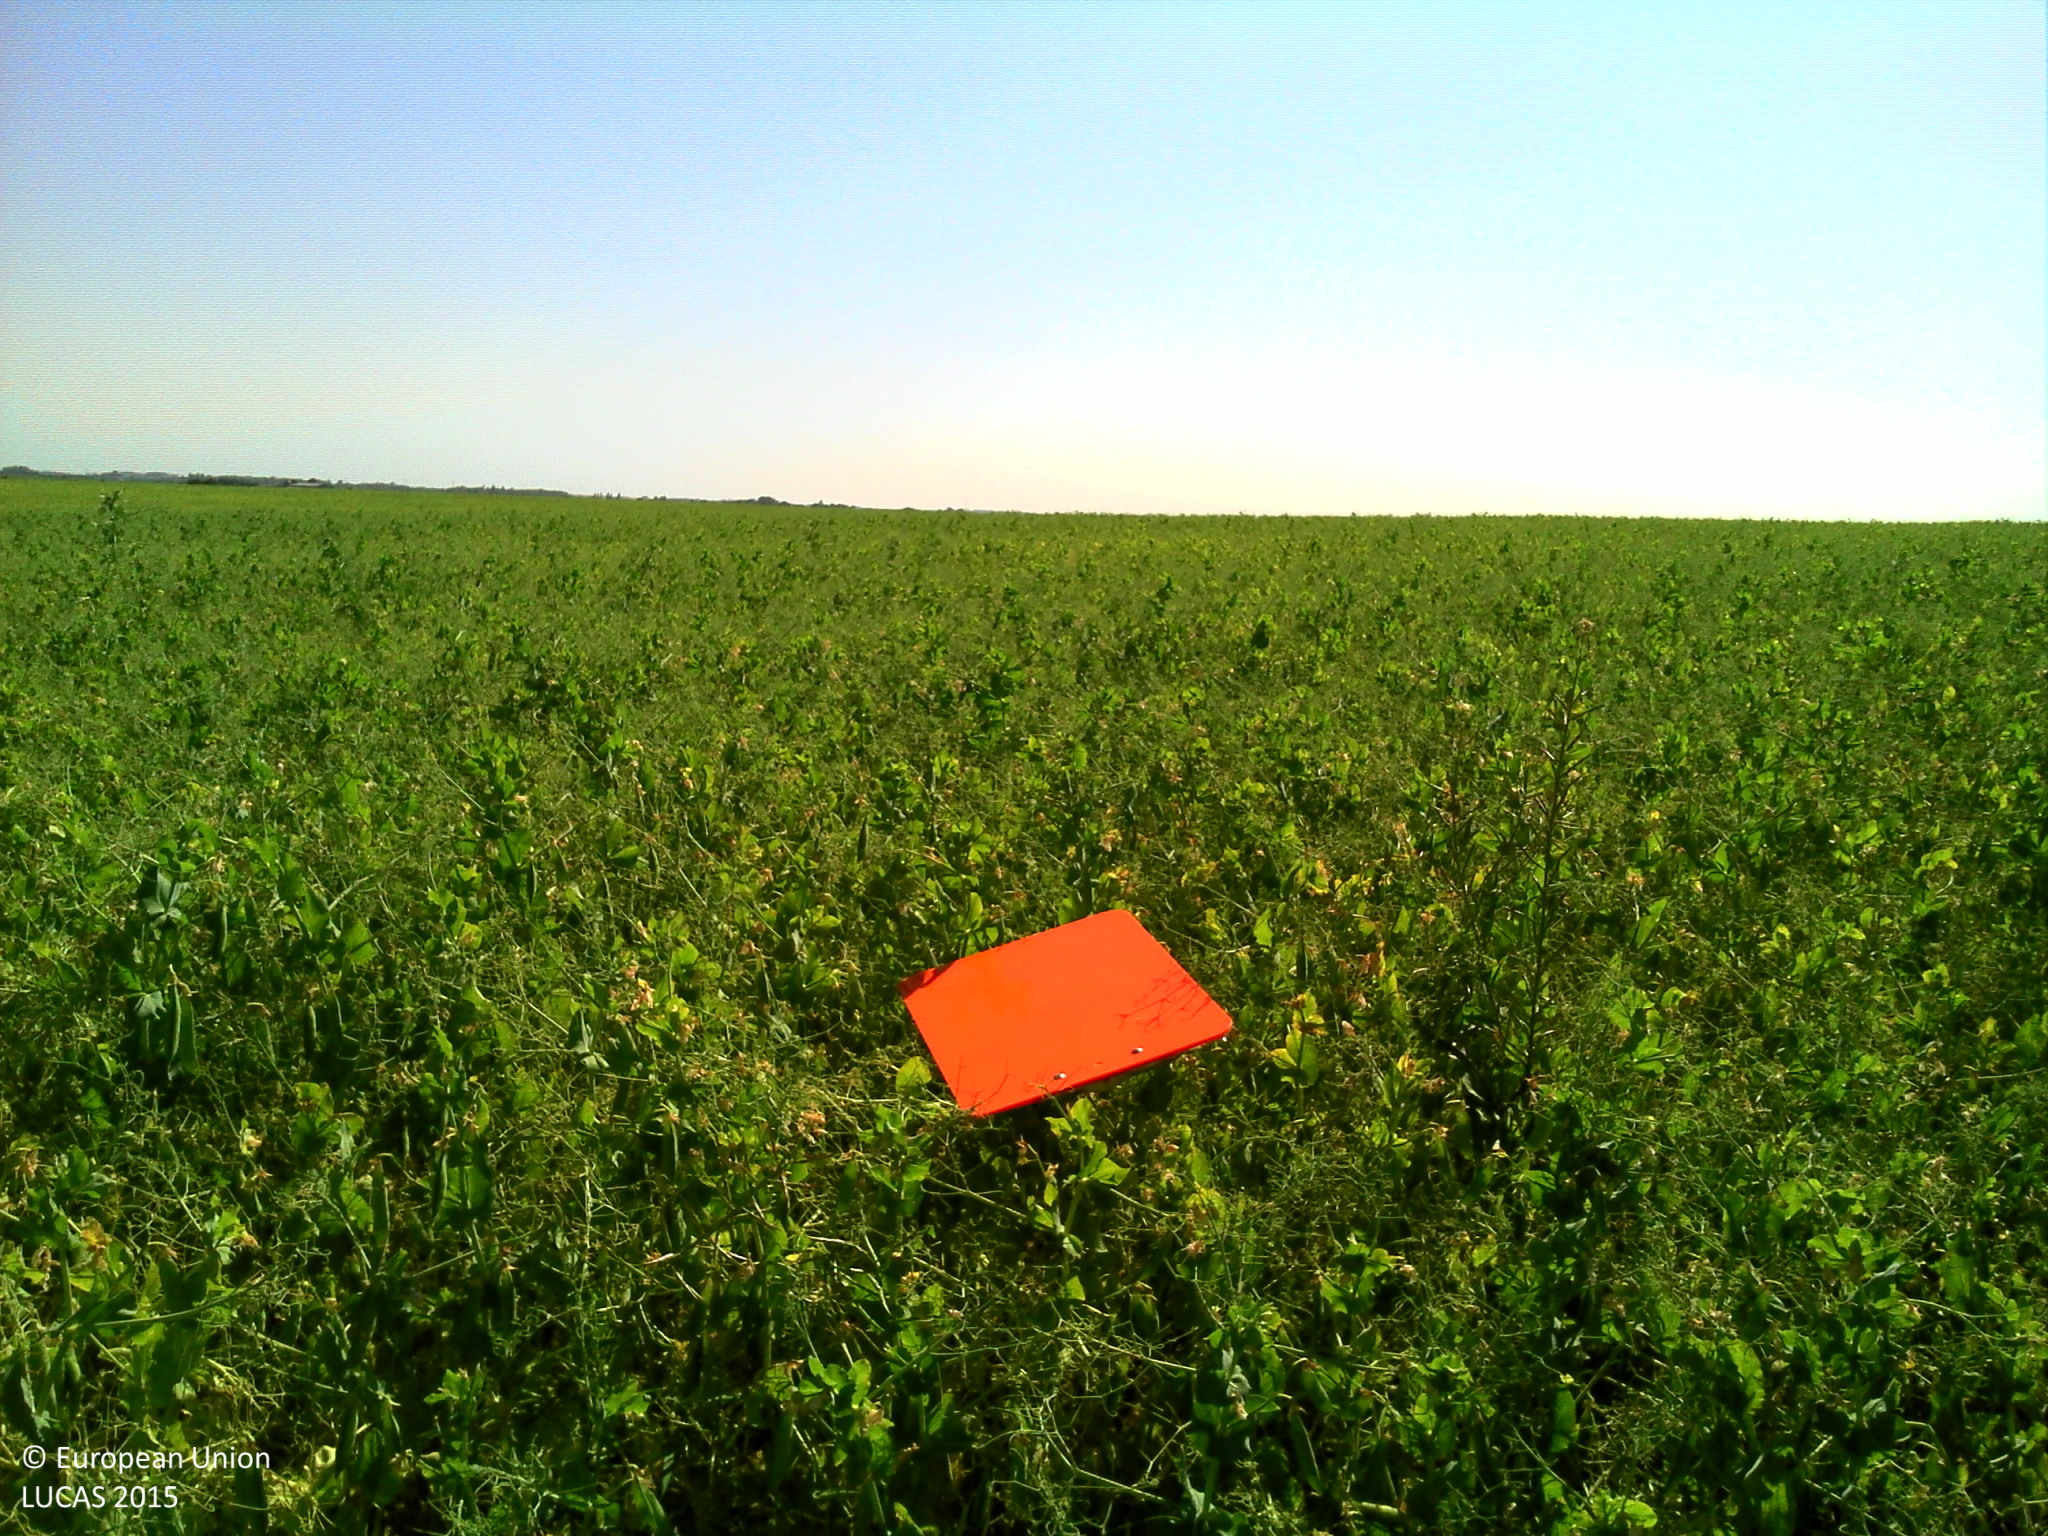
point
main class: Cropland
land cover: Dry pulses
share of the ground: > 75 %
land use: Agriculture (excluding fallow land and kitchen gardens)
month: June
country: FR
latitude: 46.2019
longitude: -0.9811
